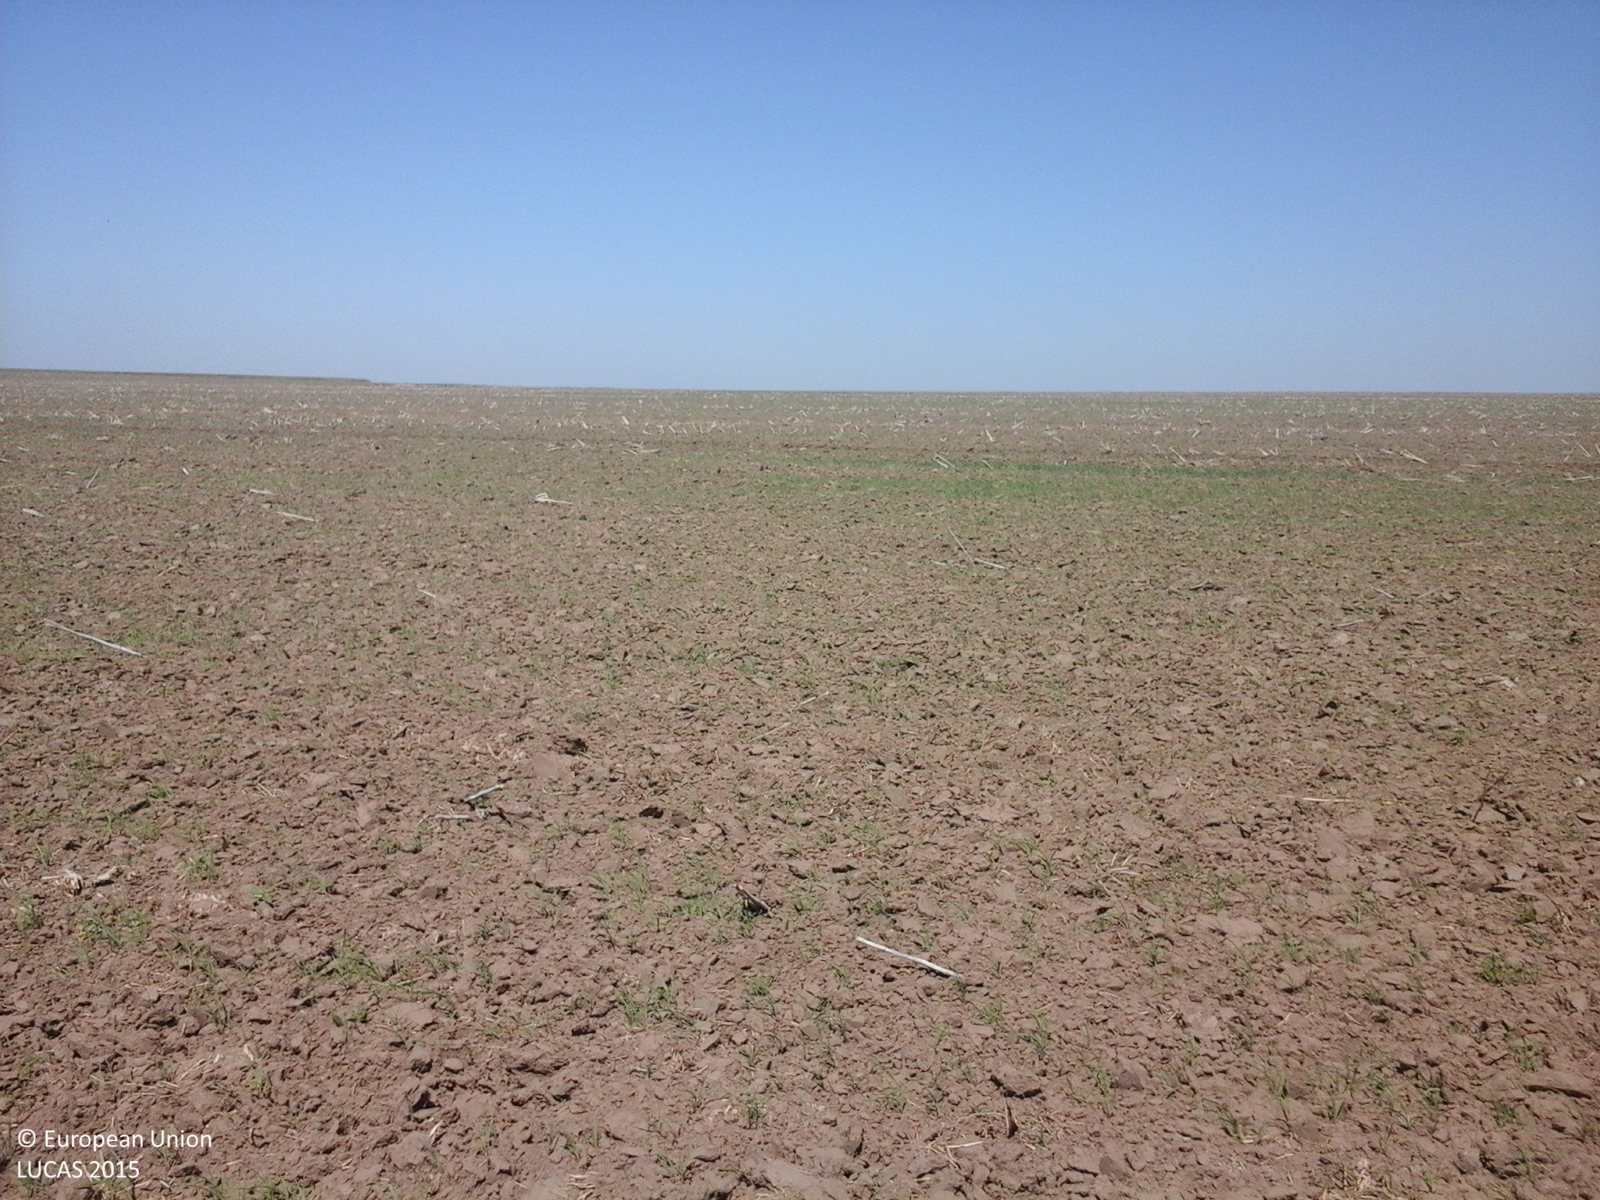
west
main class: Cropland
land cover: Rape and turnip rape
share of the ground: < 10 %
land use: Agriculture (excluding fallow land and kitchen gardens)
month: August
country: RO
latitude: 44.6595
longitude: 28.1091
